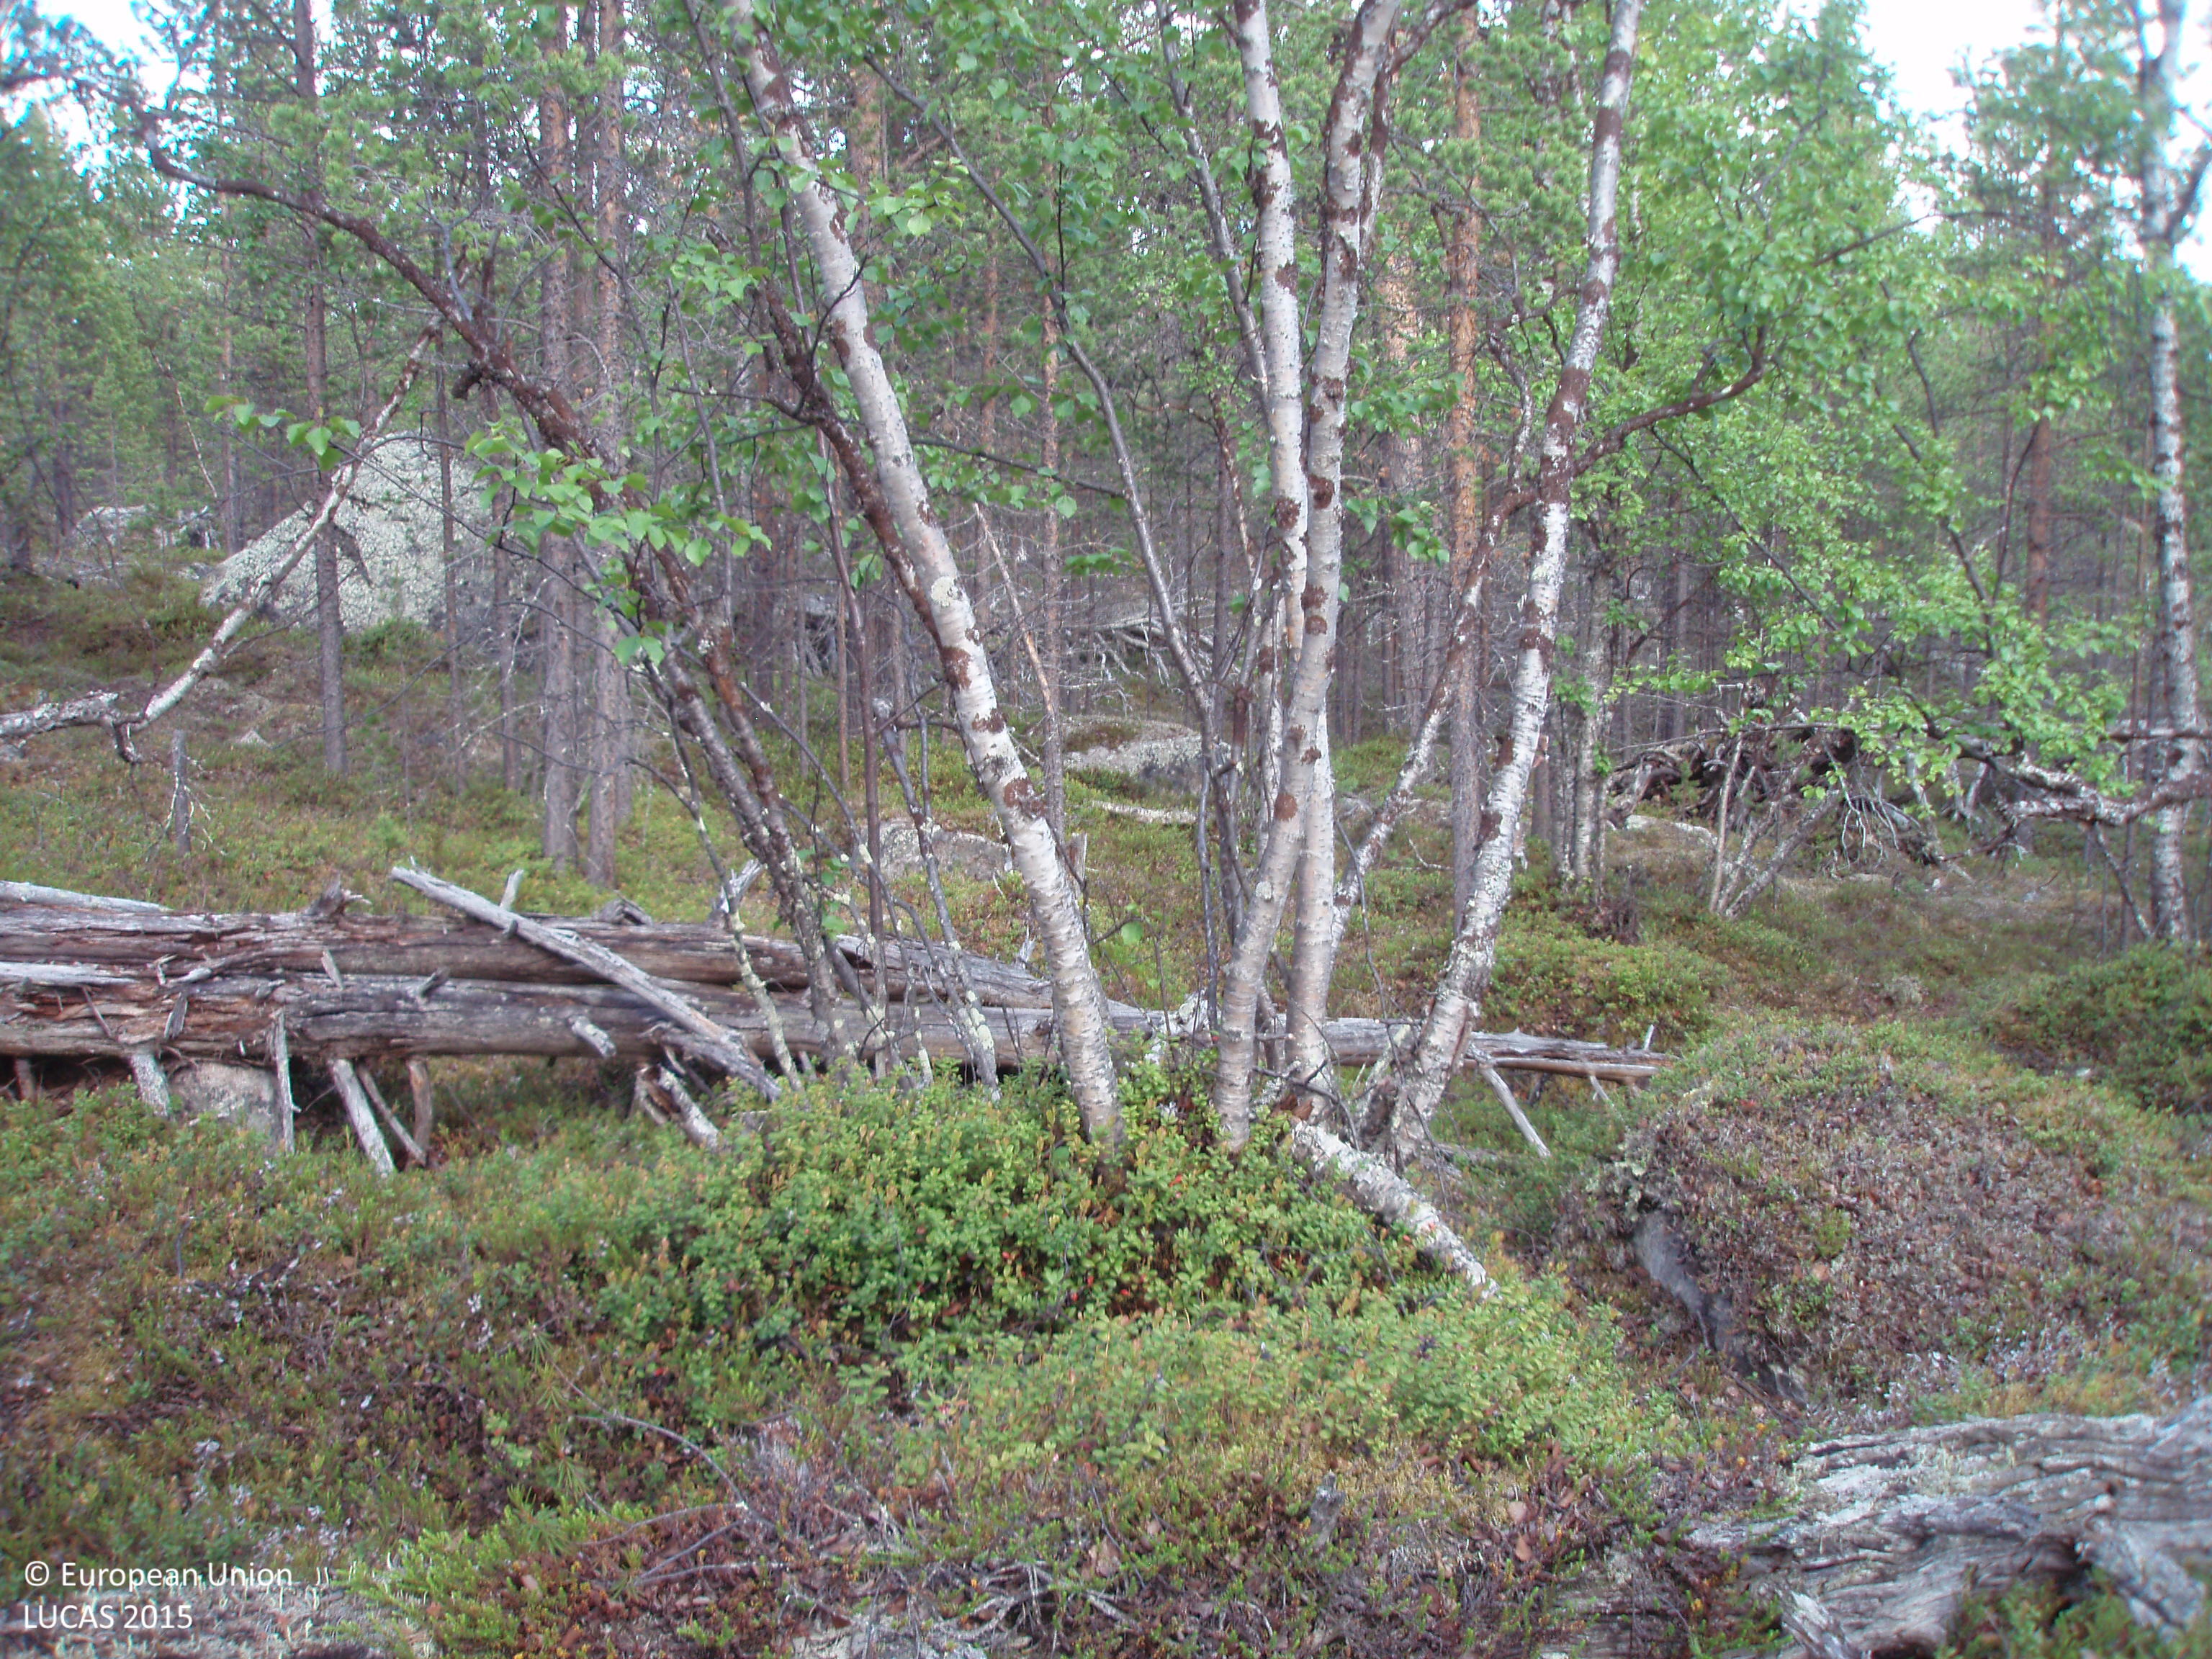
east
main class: Woodland
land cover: Pine dominated mixed woodland
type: boreal forest
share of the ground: > 75 %
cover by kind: broadleaved forest trees 45 %, coniferous forest trees 35 %, shrubs 20 %
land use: Forestry
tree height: > 5 m
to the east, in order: Pine dominated mixed woodland
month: July
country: FI
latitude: 69.5867
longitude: 28.7734
